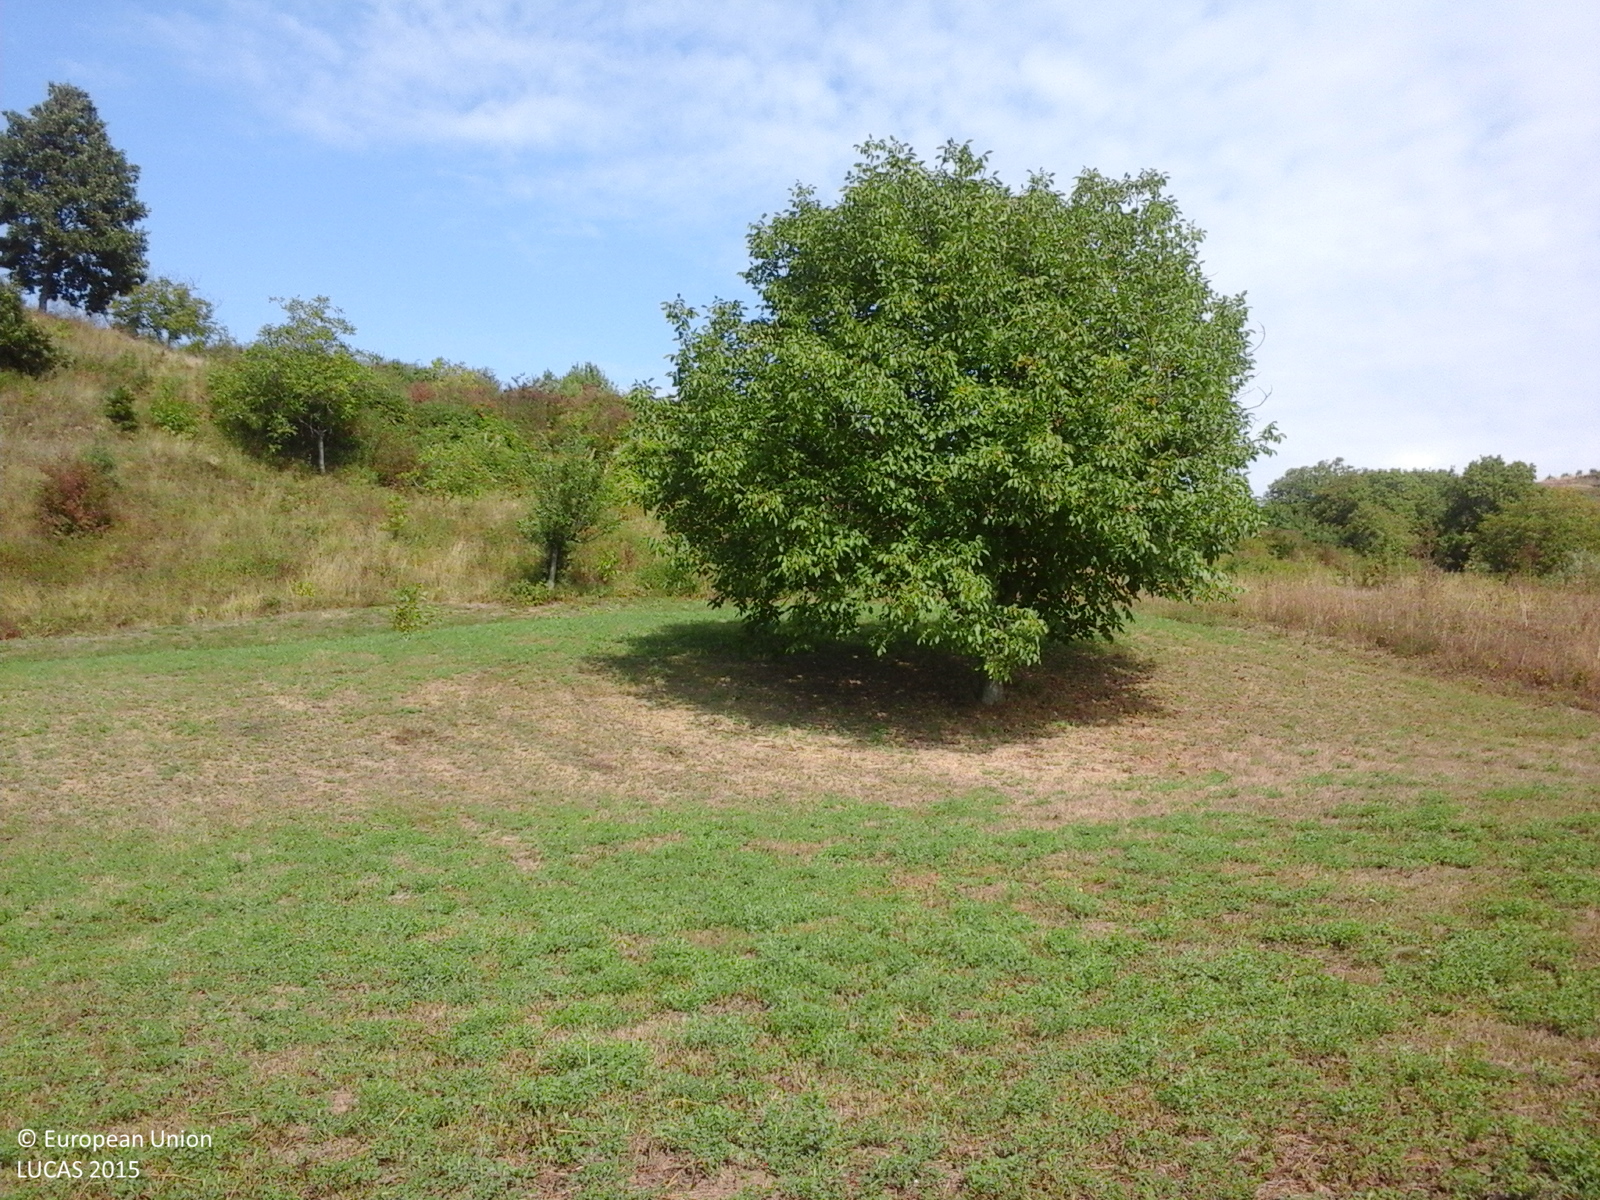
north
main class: Cropland
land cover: Lucerne
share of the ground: > 75 %
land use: Agriculture (excluding fallow land and kitchen gardens)
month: September
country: RO
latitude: 47.3510
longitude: 23.2131
